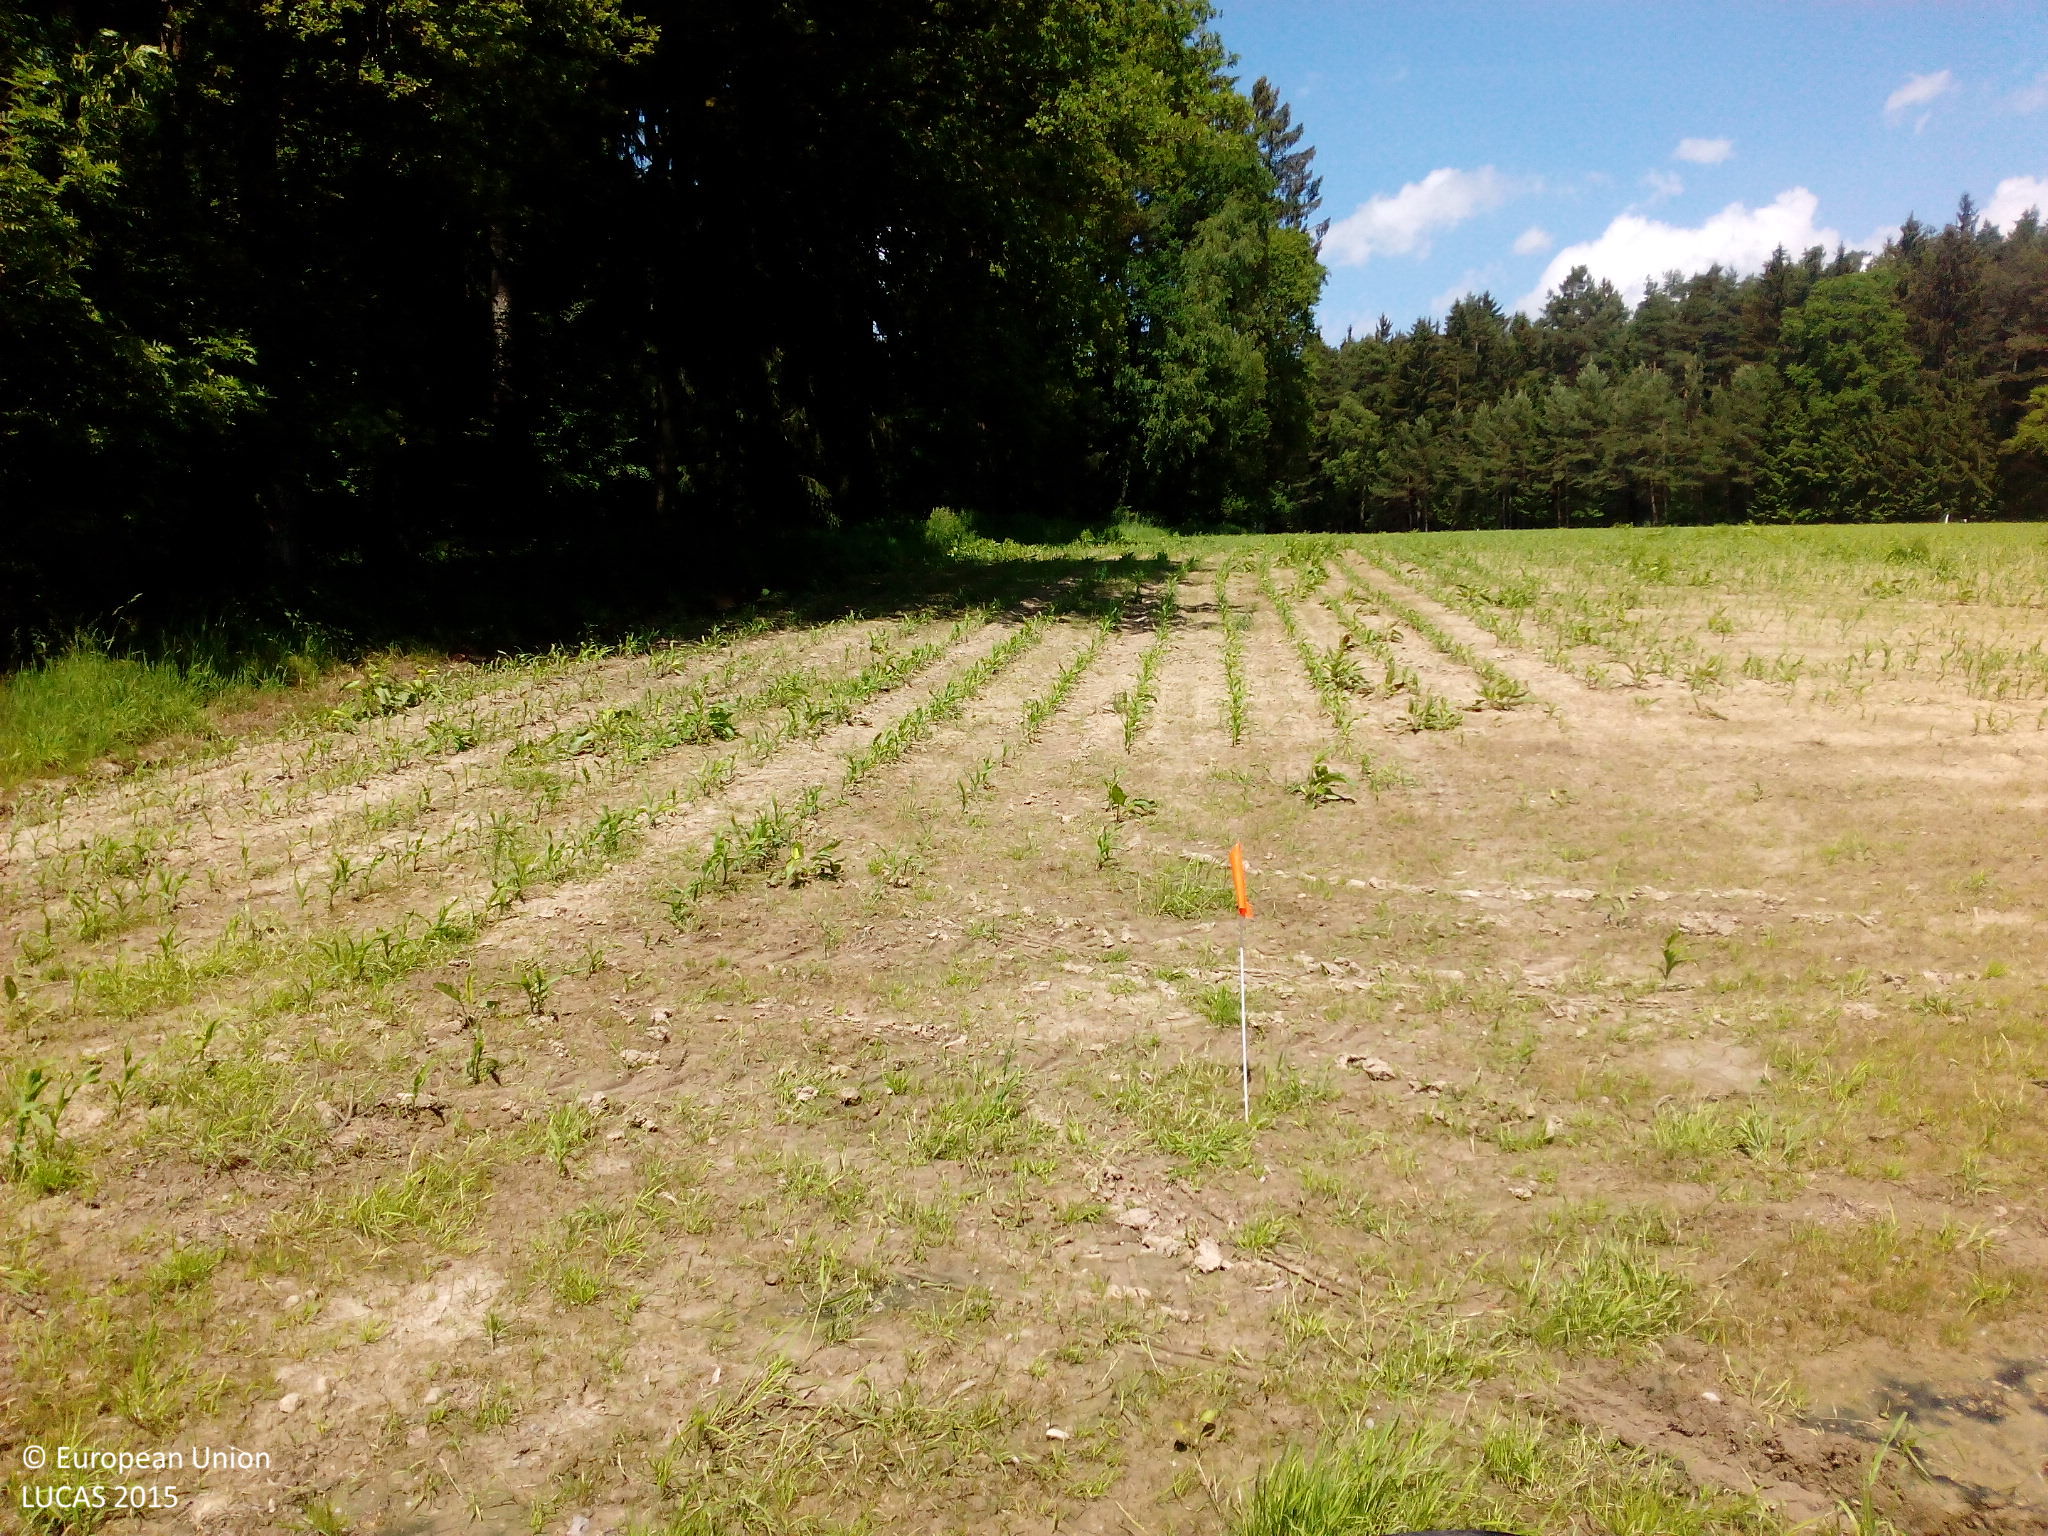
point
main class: Cropland
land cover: Maize
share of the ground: < 10 %
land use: Agriculture (excluding fallow land and kitchen gardens)
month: June
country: DE
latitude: 48.5216
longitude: 12.3956
